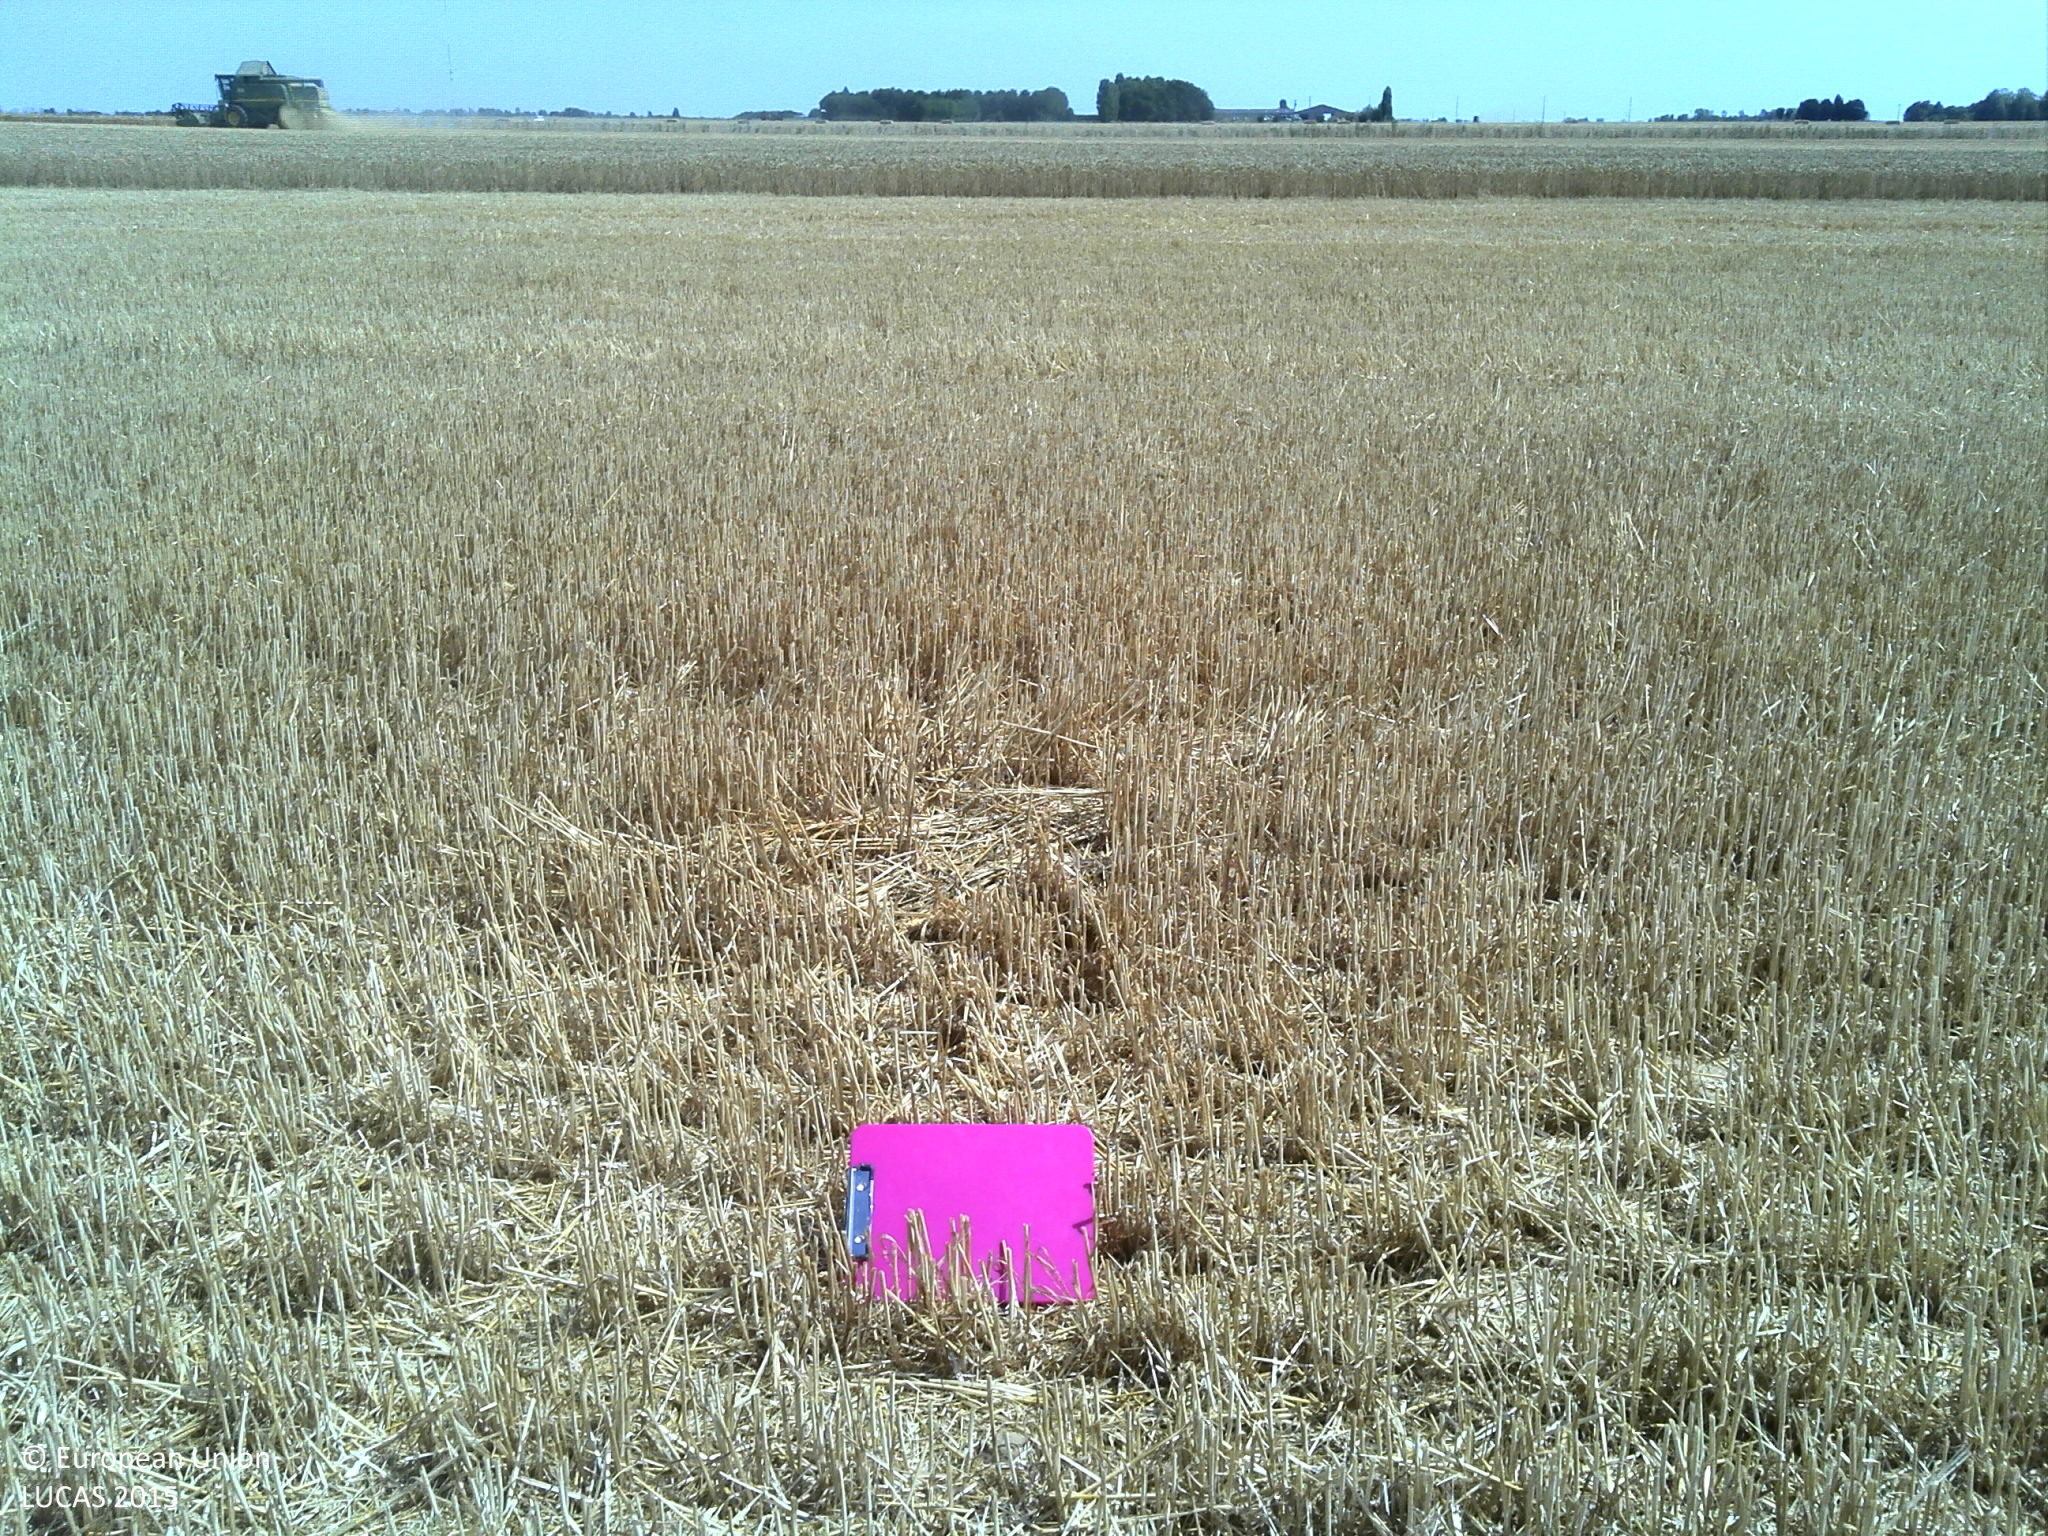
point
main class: Cropland
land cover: Common wheat
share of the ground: > 75 %
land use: Agriculture (excluding fallow land and kitchen gardens)
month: July
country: FR
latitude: 48.4665
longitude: 1.8845
